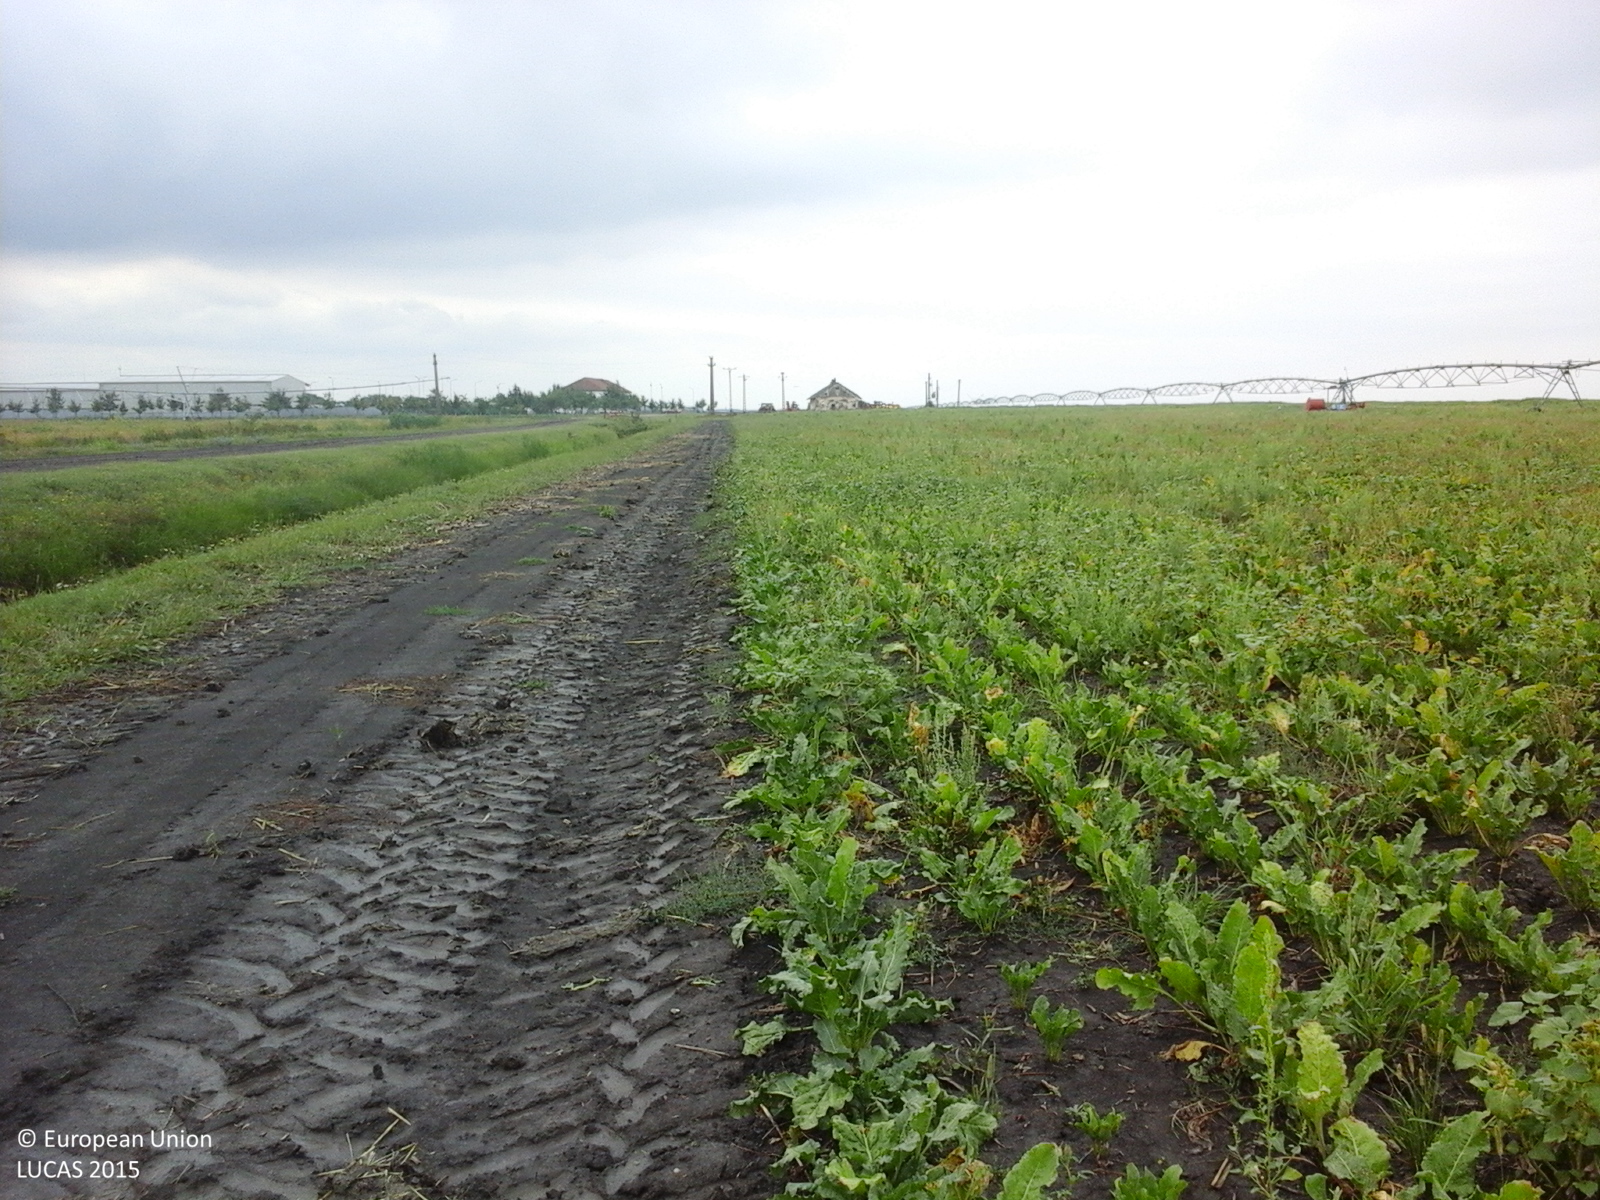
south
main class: Cropland
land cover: Sugar beet
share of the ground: > 75 %
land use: Agriculture (excluding fallow land and kitchen gardens)
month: August
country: RO
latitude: 46.0629
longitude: 20.3778
